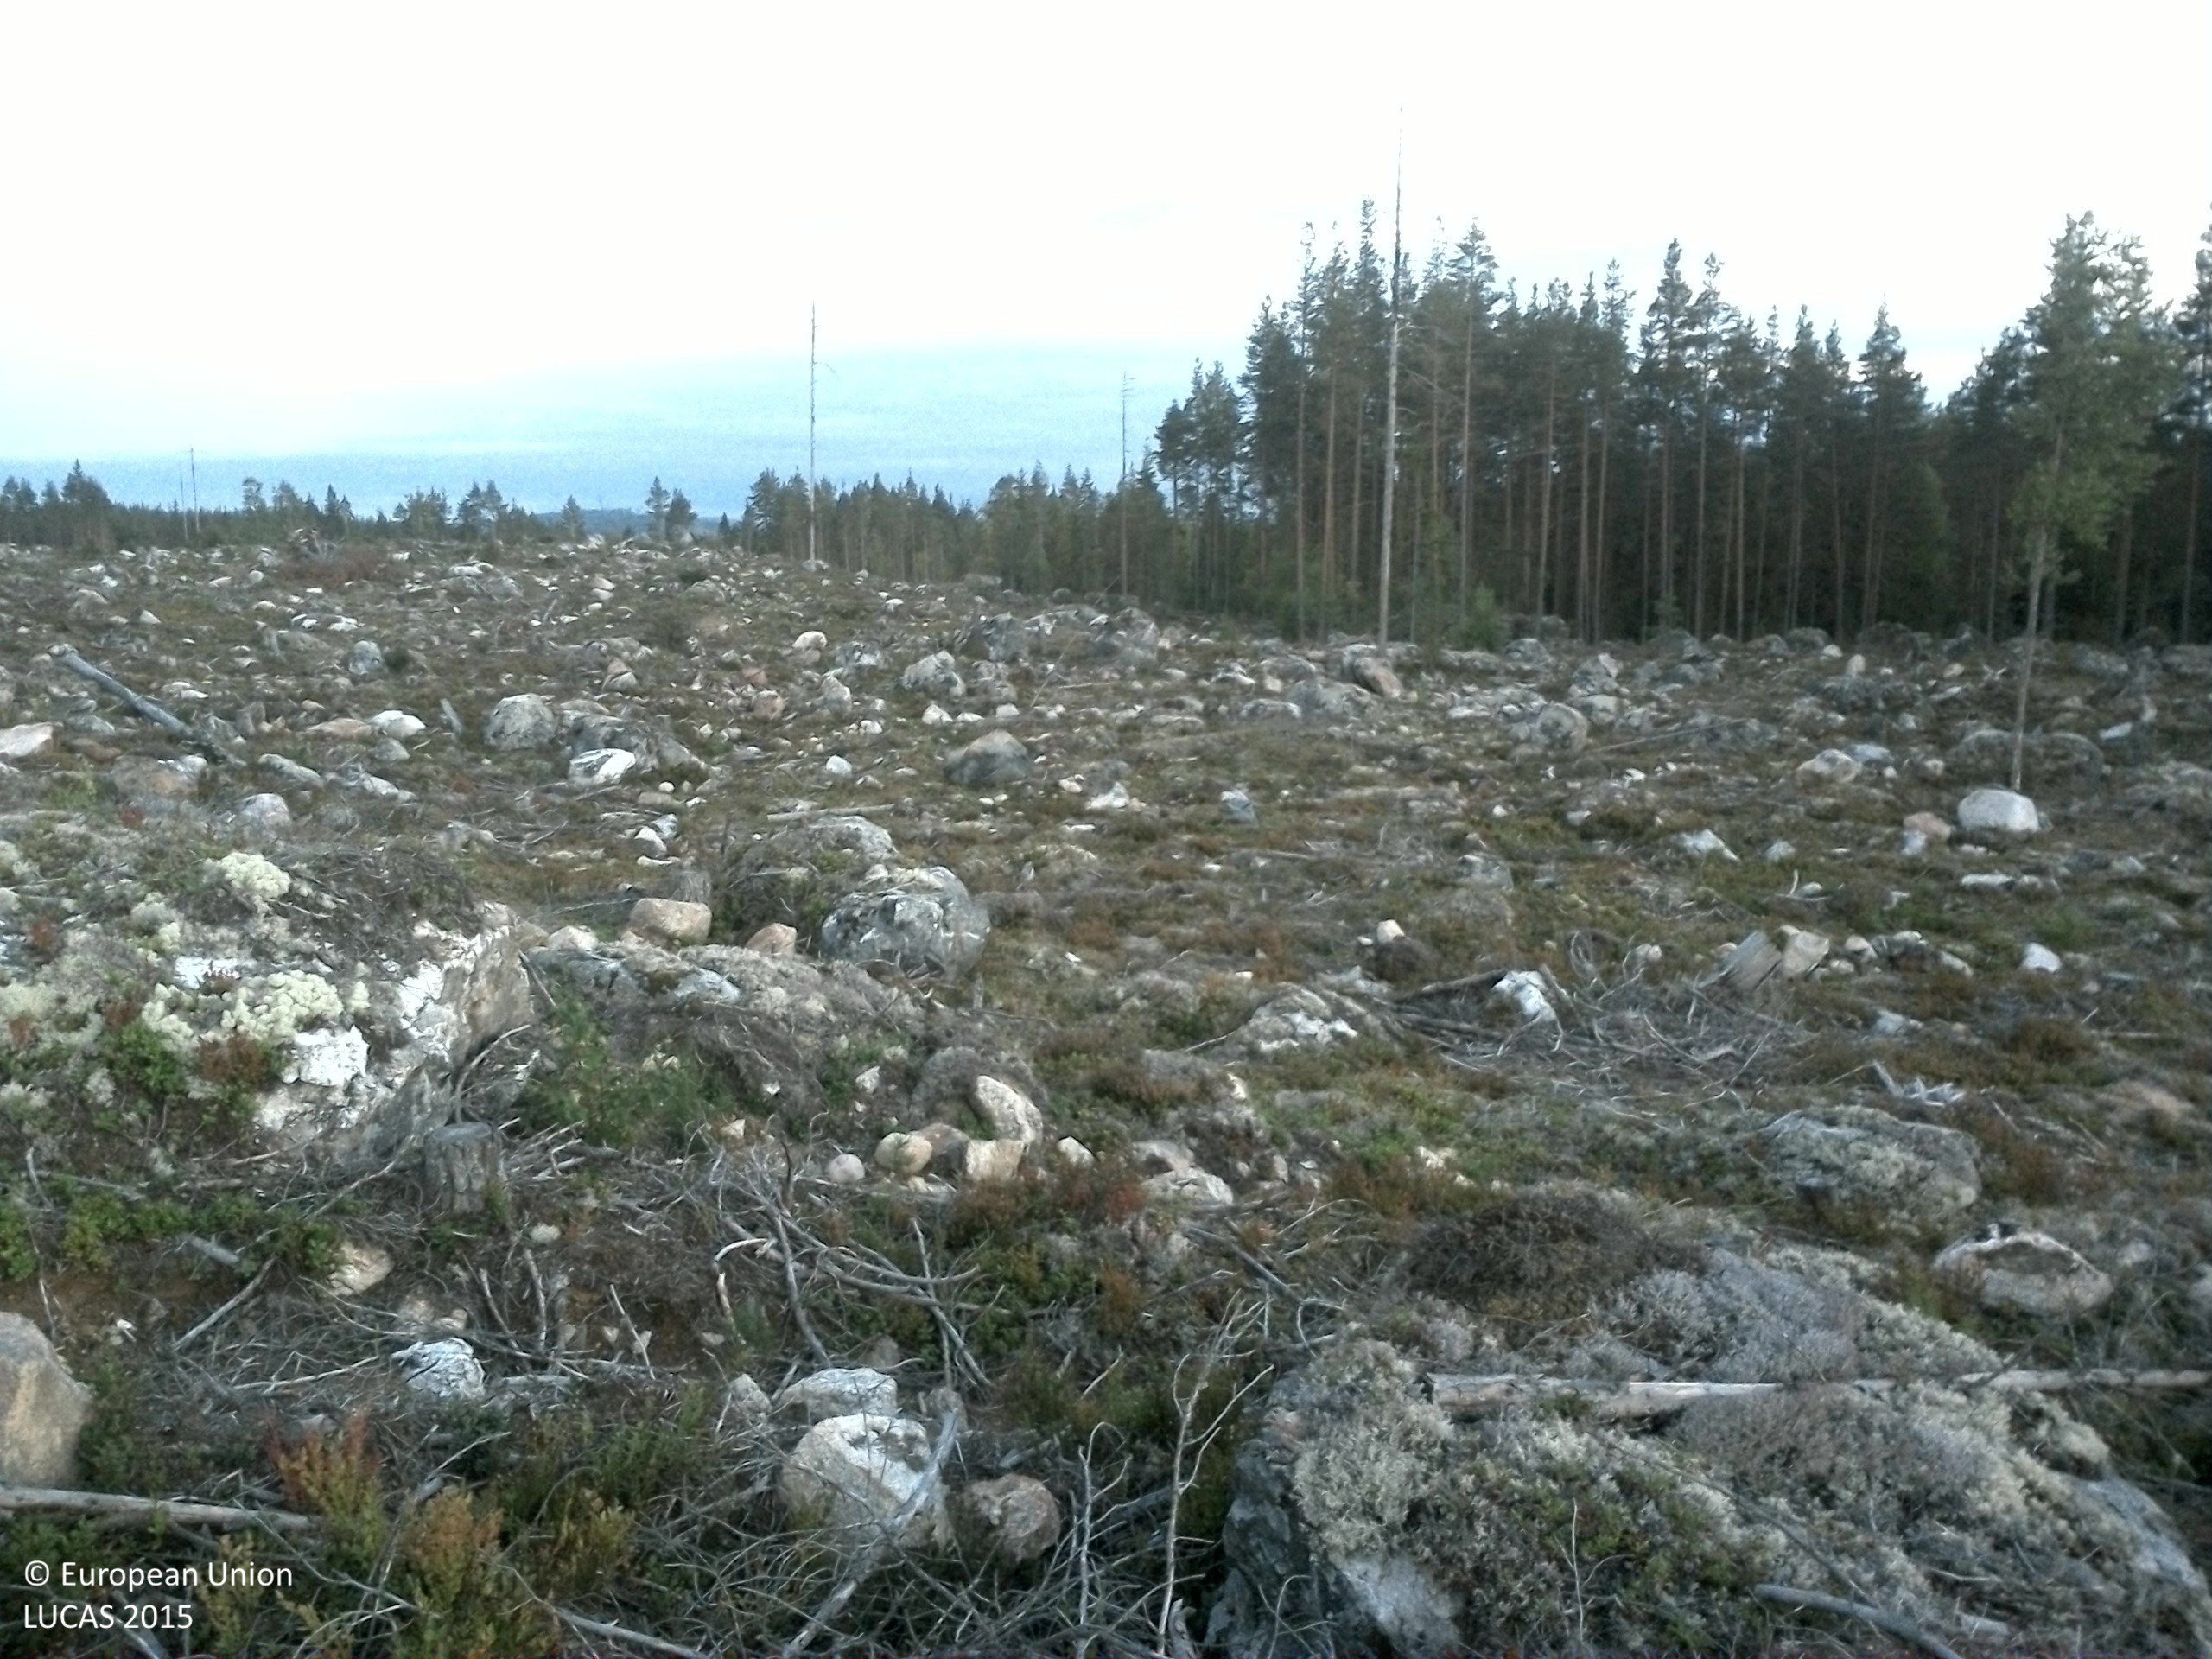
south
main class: Shrubland
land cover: Shrubland without tree cover
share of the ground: 50 - 75 %
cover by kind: shrubs 50 %, consolidated bare surface 40 %, lichens and mosses 10 %
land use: Forestry
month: September
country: SE
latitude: 61.5943
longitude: 15.3918
